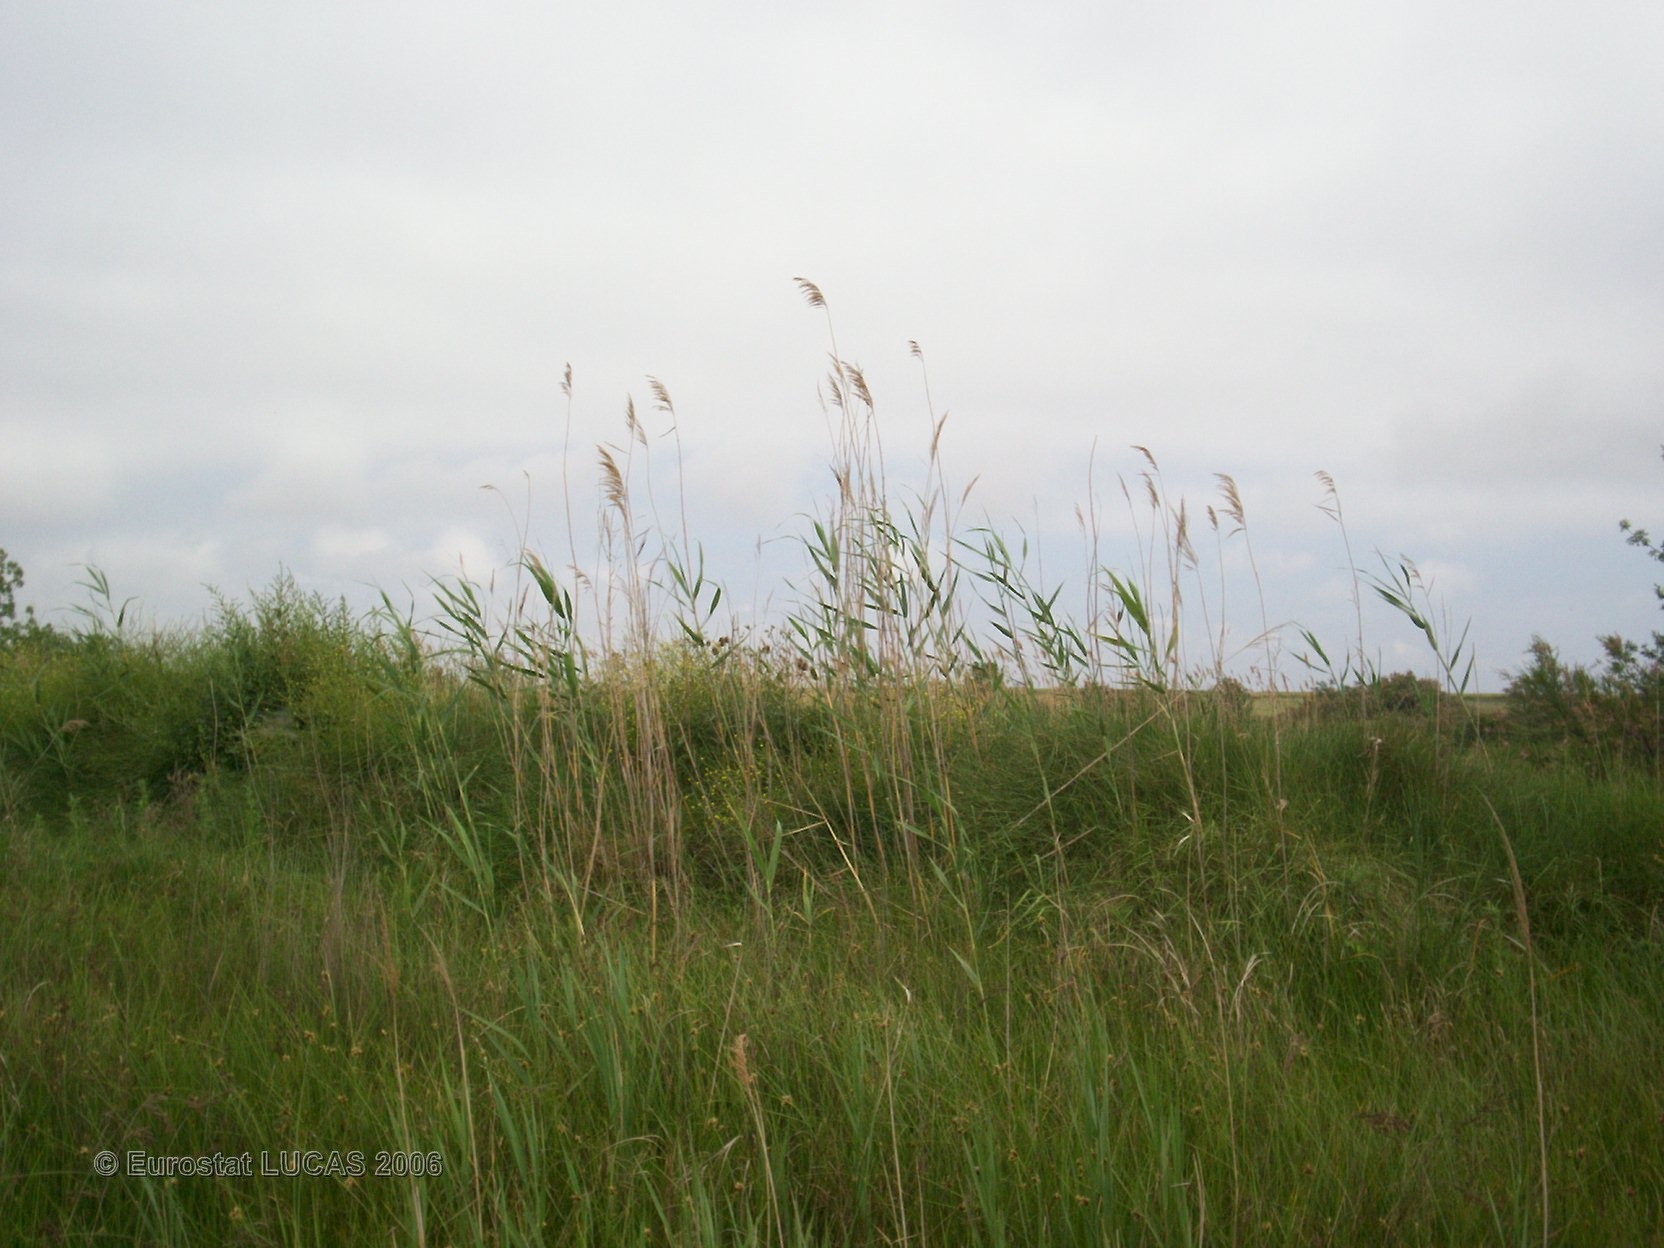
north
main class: Grassland
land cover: Grassland without tree/shrub cover
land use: Unused
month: May
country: FR
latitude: 43.3330
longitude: 3.5101
